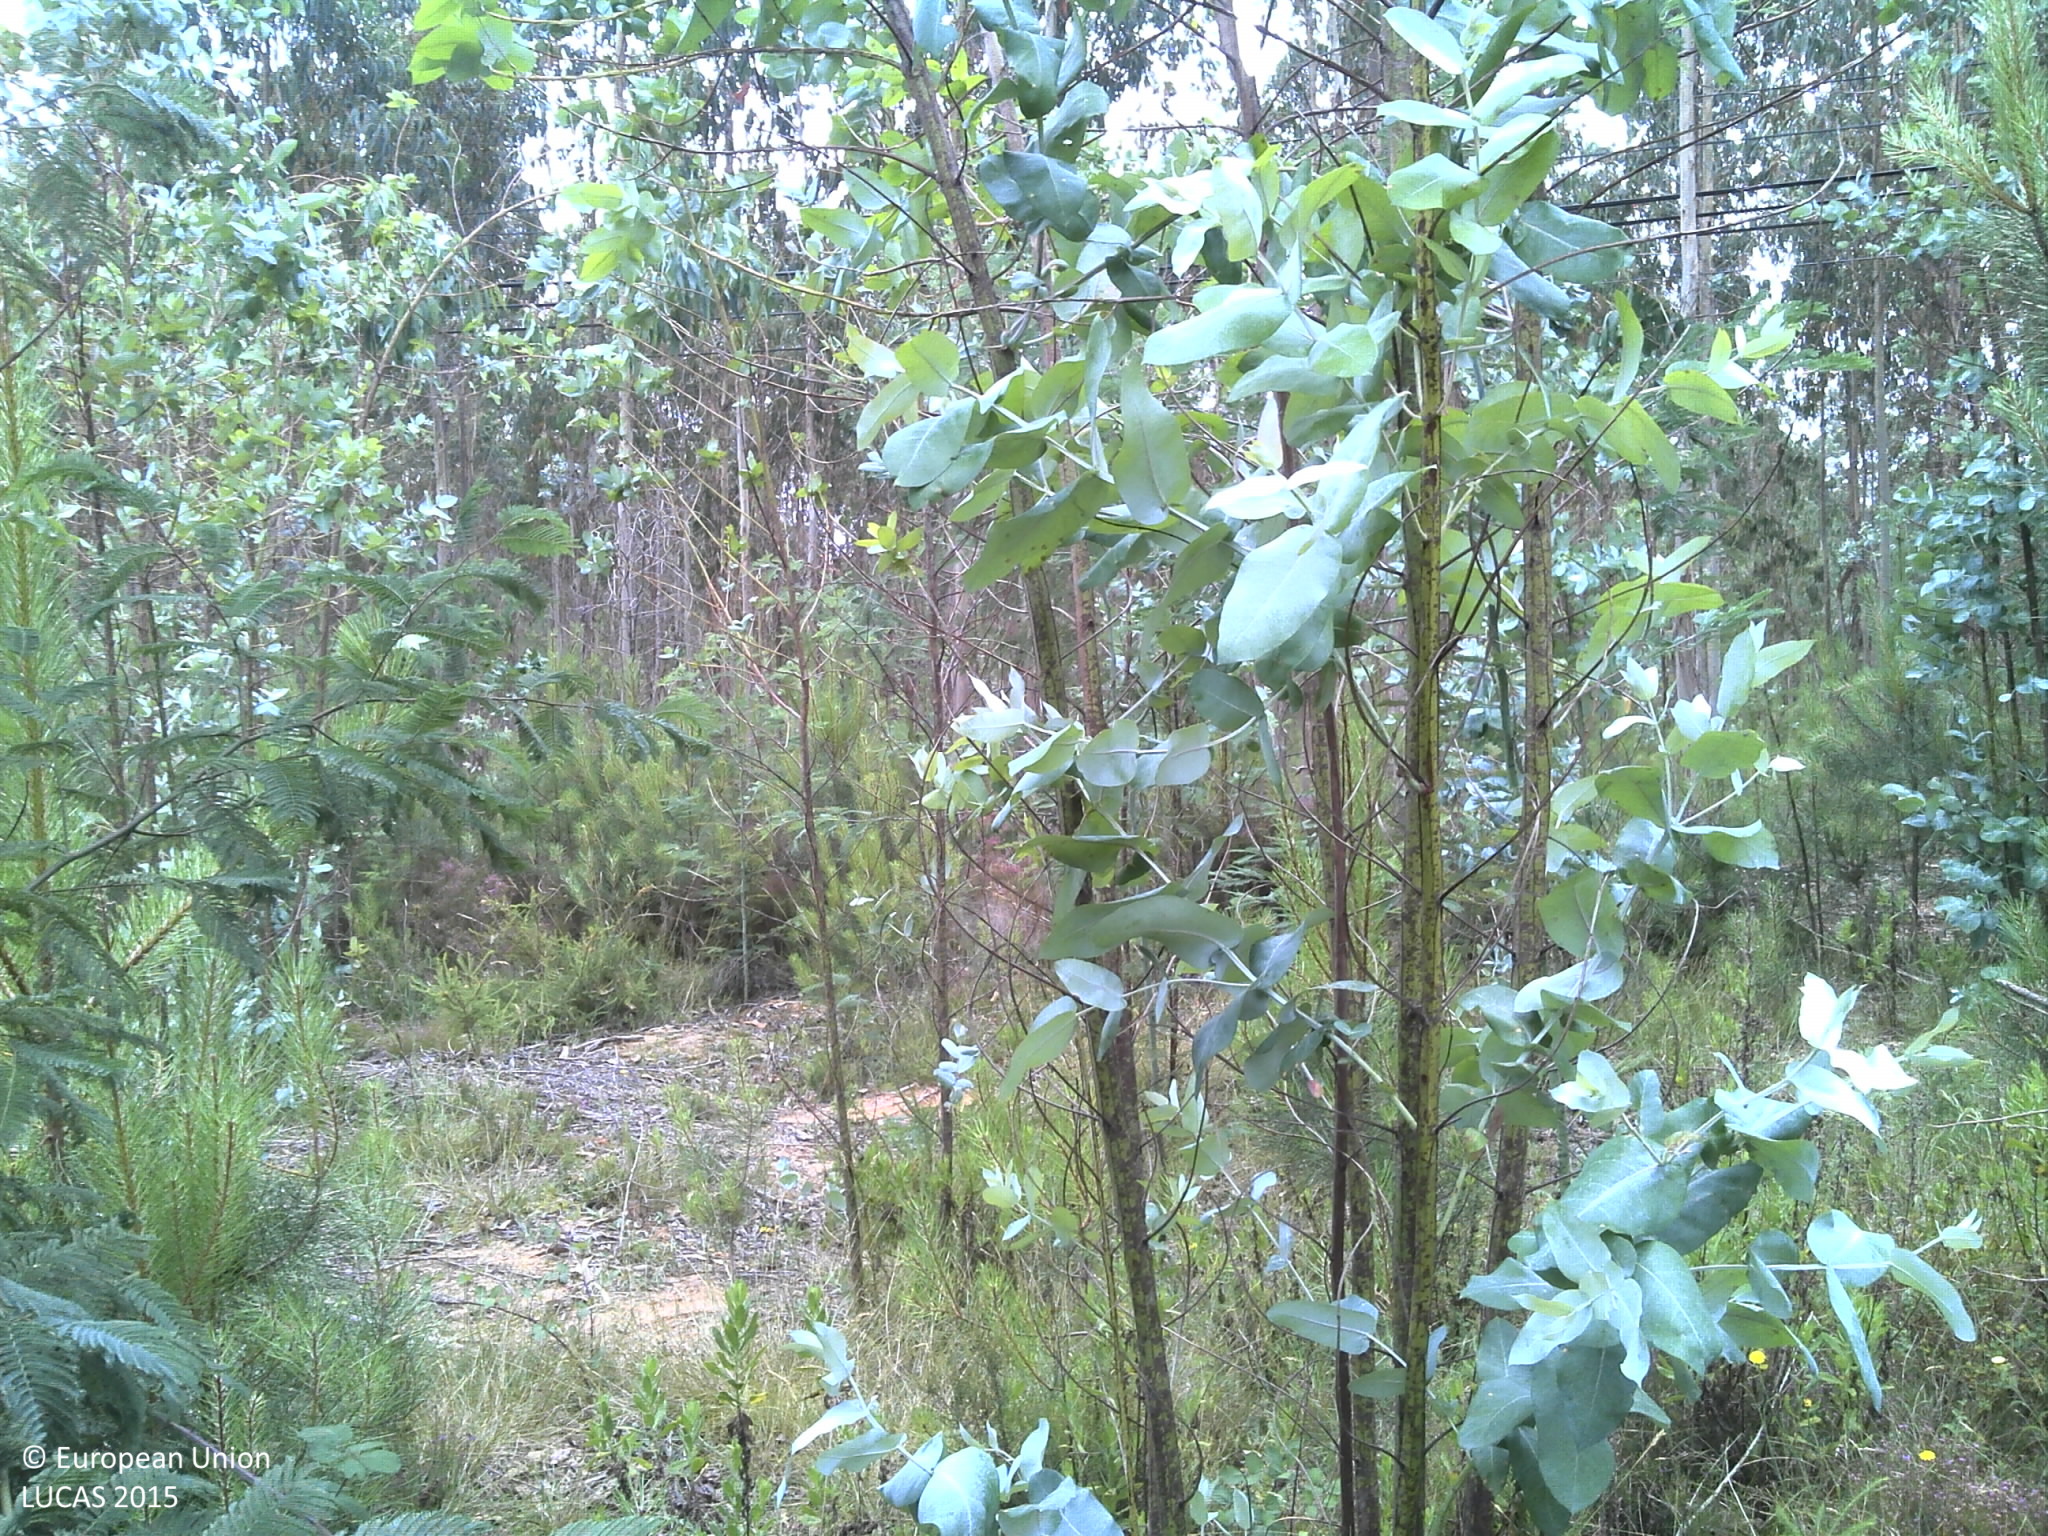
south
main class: Woodland
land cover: Broadleaved woodland
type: exotic forest
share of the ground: 50 - 75 %
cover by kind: broadleaved forest trees 70 %, shrubs 20 %, unconsolidated bare surface 10 %
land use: Forestry
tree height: > 5 m
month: June
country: PT
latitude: 40.2332
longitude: -8.6730
